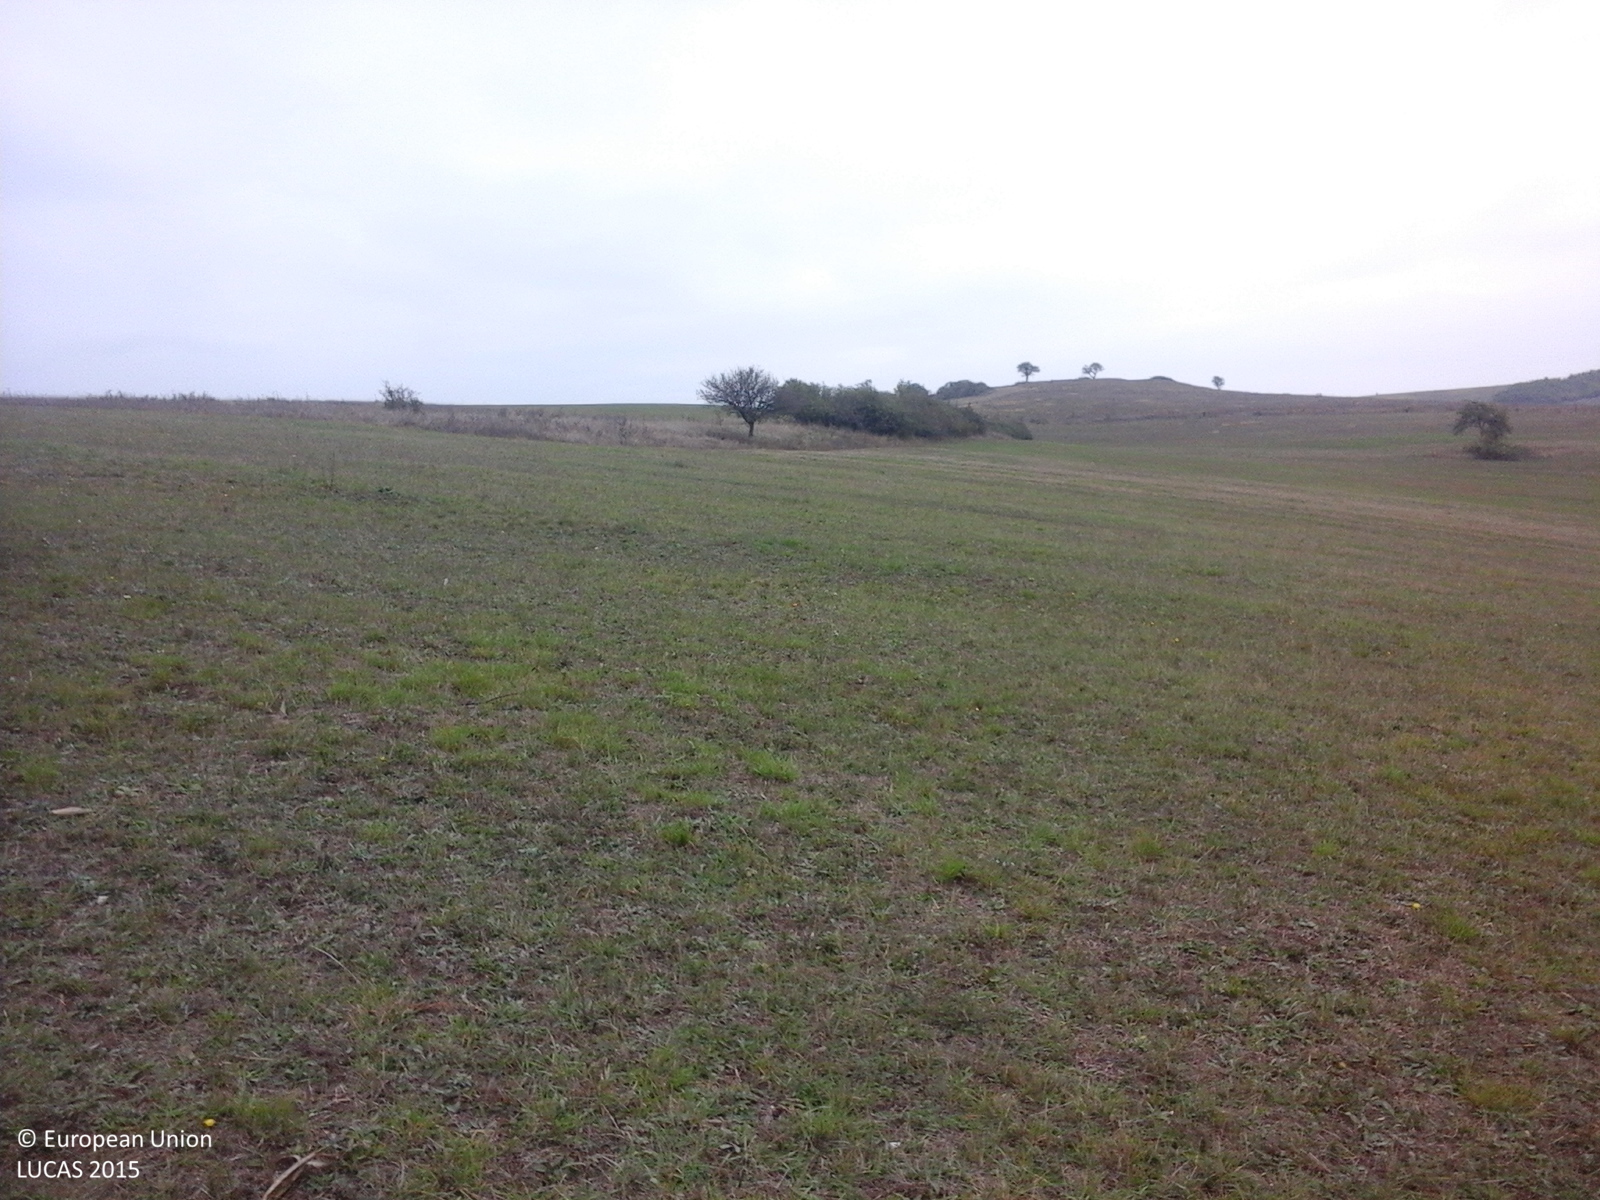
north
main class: Grassland
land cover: Grassland without tree/shrub cover
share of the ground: > 75 %
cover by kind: herbaceous plants 100 %
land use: Agriculture (excluding fallow land and kitchen gardens)
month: October
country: RO
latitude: 46.1104
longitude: 25.2507
